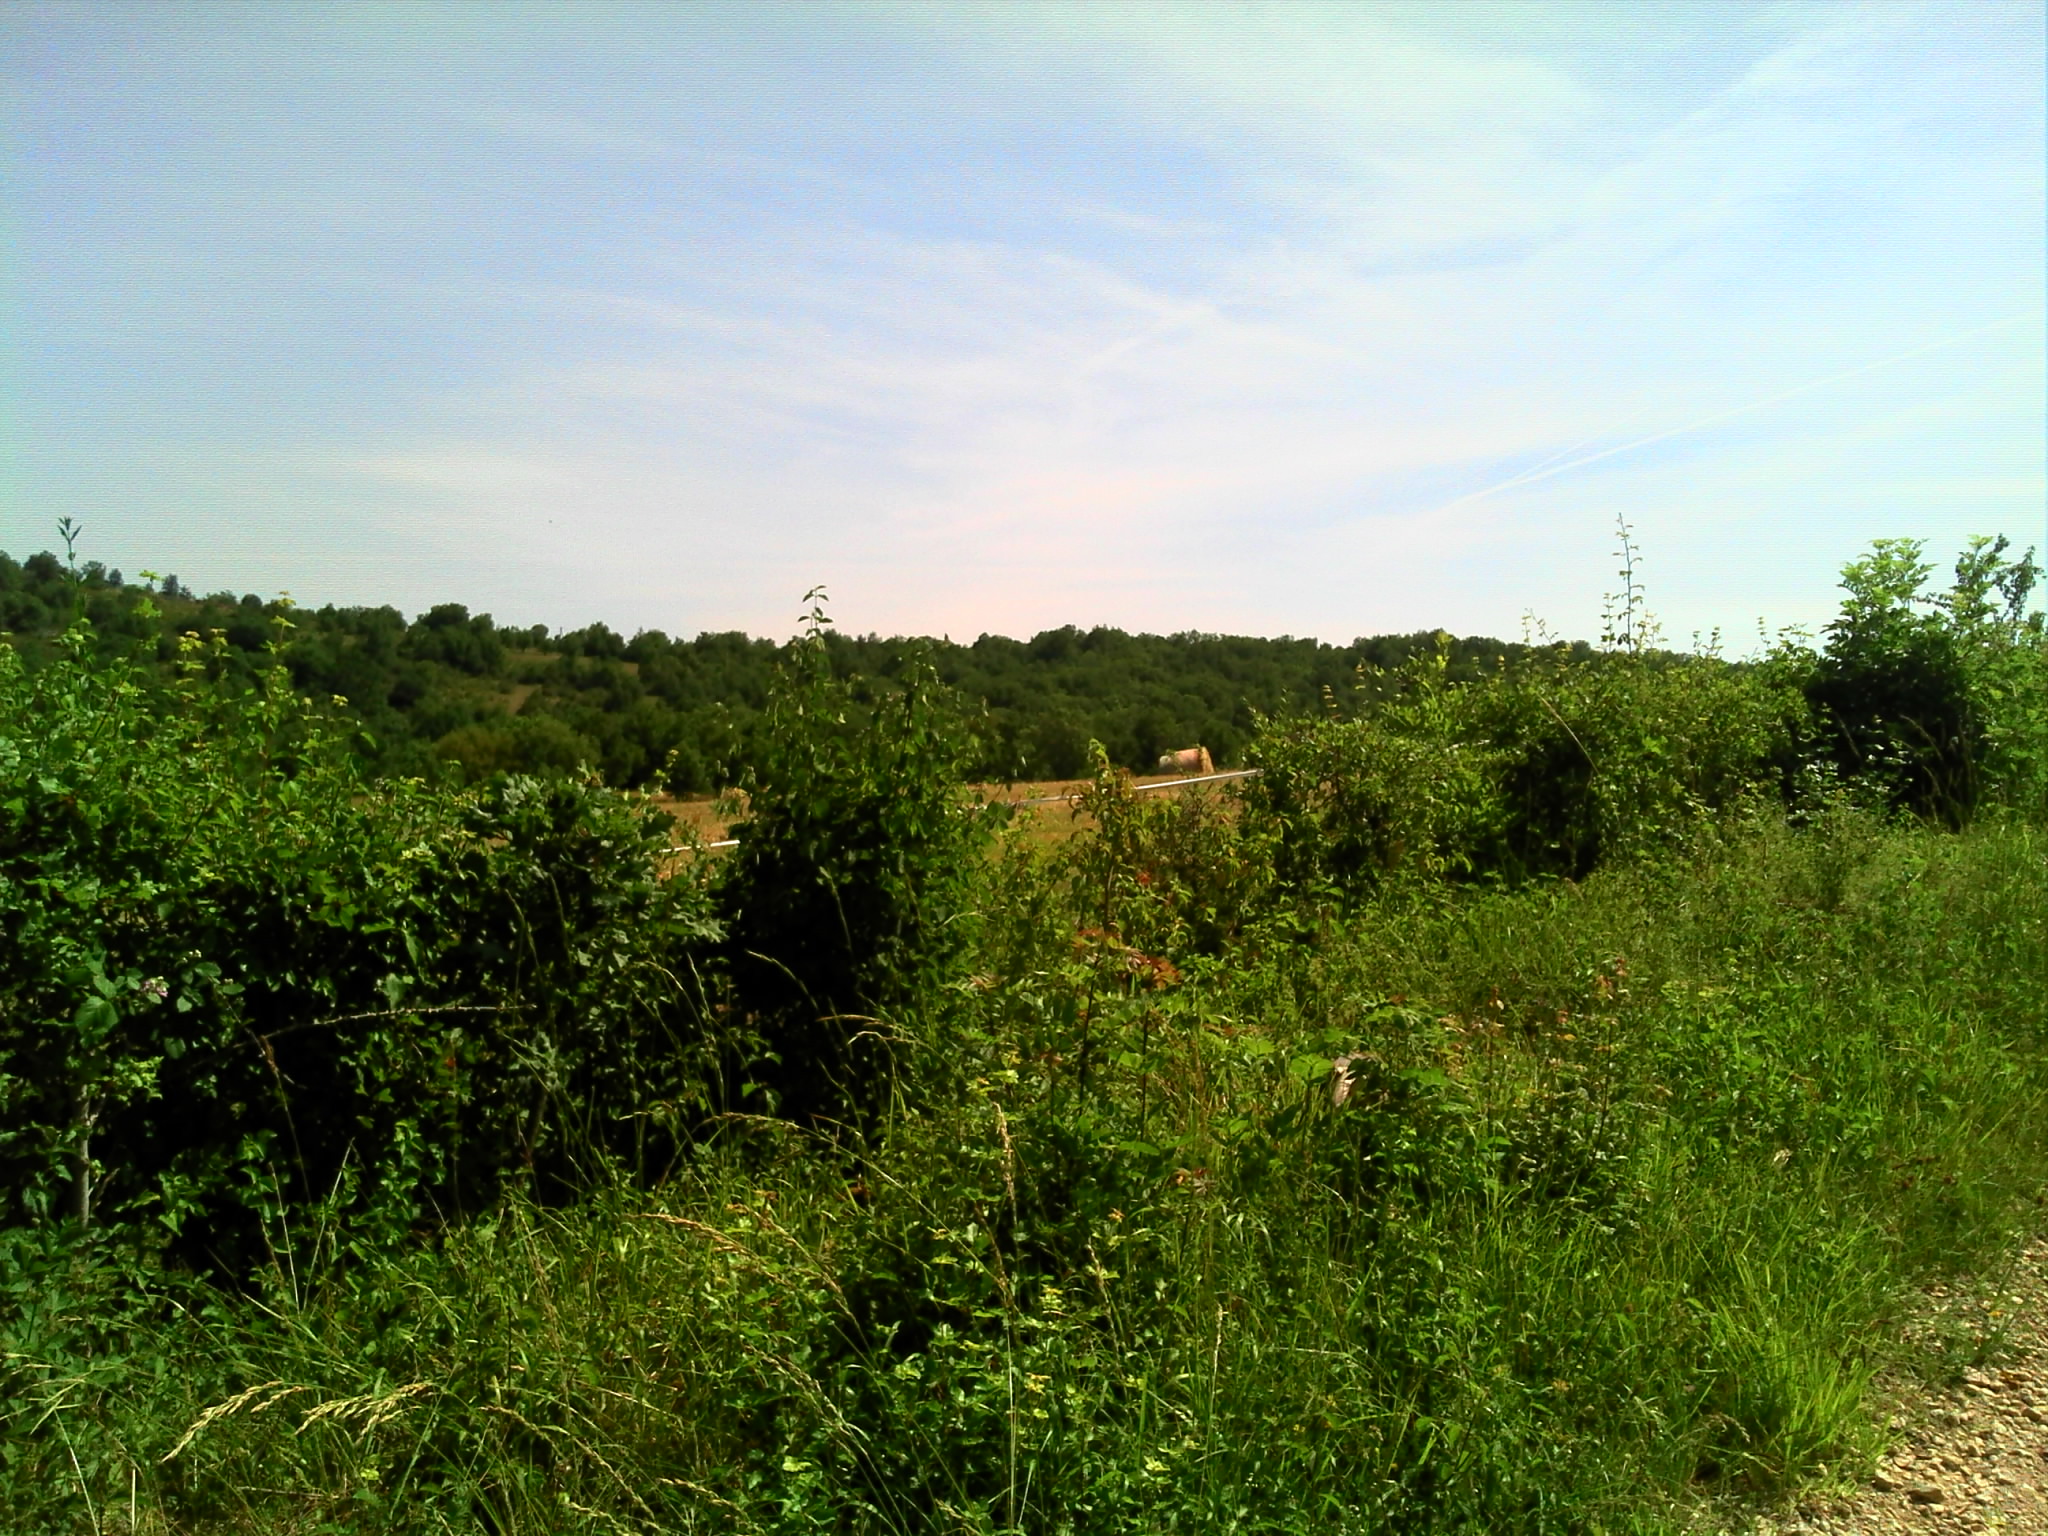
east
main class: Grassland
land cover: Grassland without tree/shrub cover
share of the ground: > 75 %
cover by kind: herbaceous plants 100 %
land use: Agriculture (excluding fallow land and kitchen gardens)
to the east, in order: Tracks; Grass margins; Managed hedges; Dry stone walls; Fences; Grassland without tree/shrub cover
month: June
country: FR
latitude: 44.4977
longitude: 1.8124
